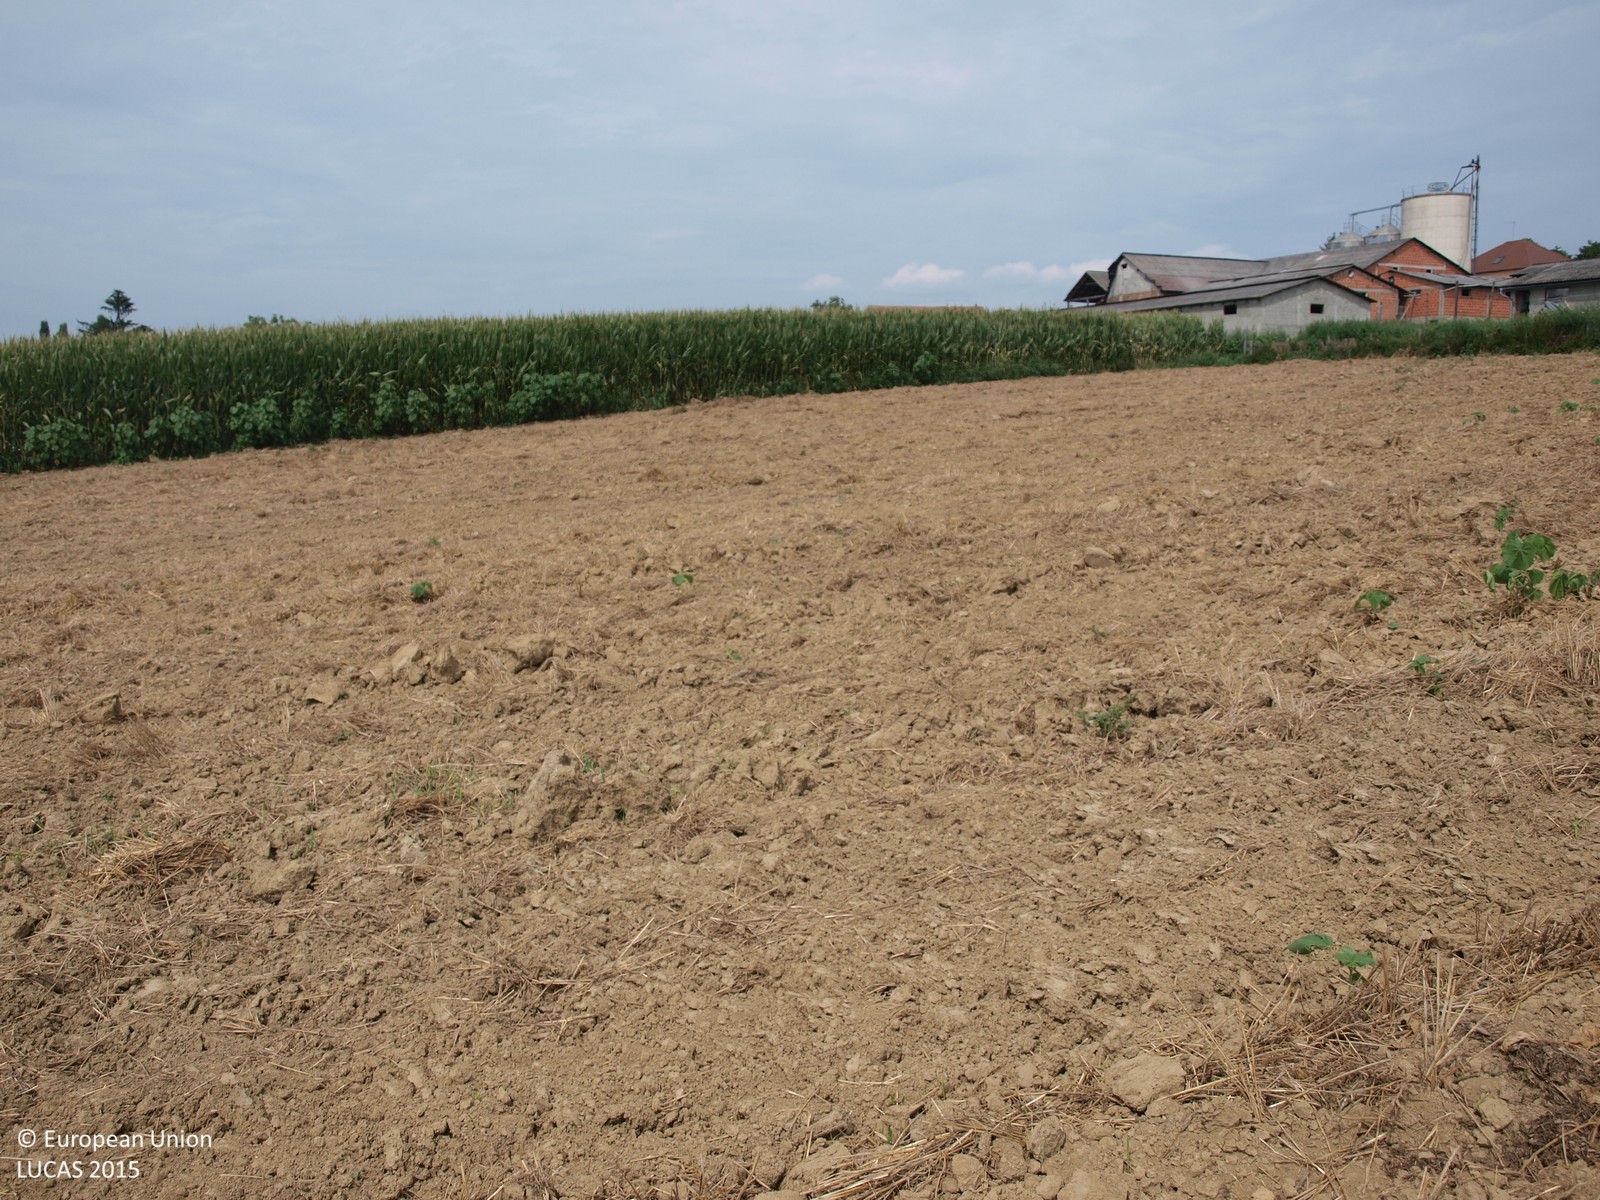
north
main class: Cropland
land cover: Barley
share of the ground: > 75 %
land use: Agriculture (excluding fallow land and kitchen gardens)
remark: Harvested field
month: August
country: HR
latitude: 46.0513
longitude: 16.3971
